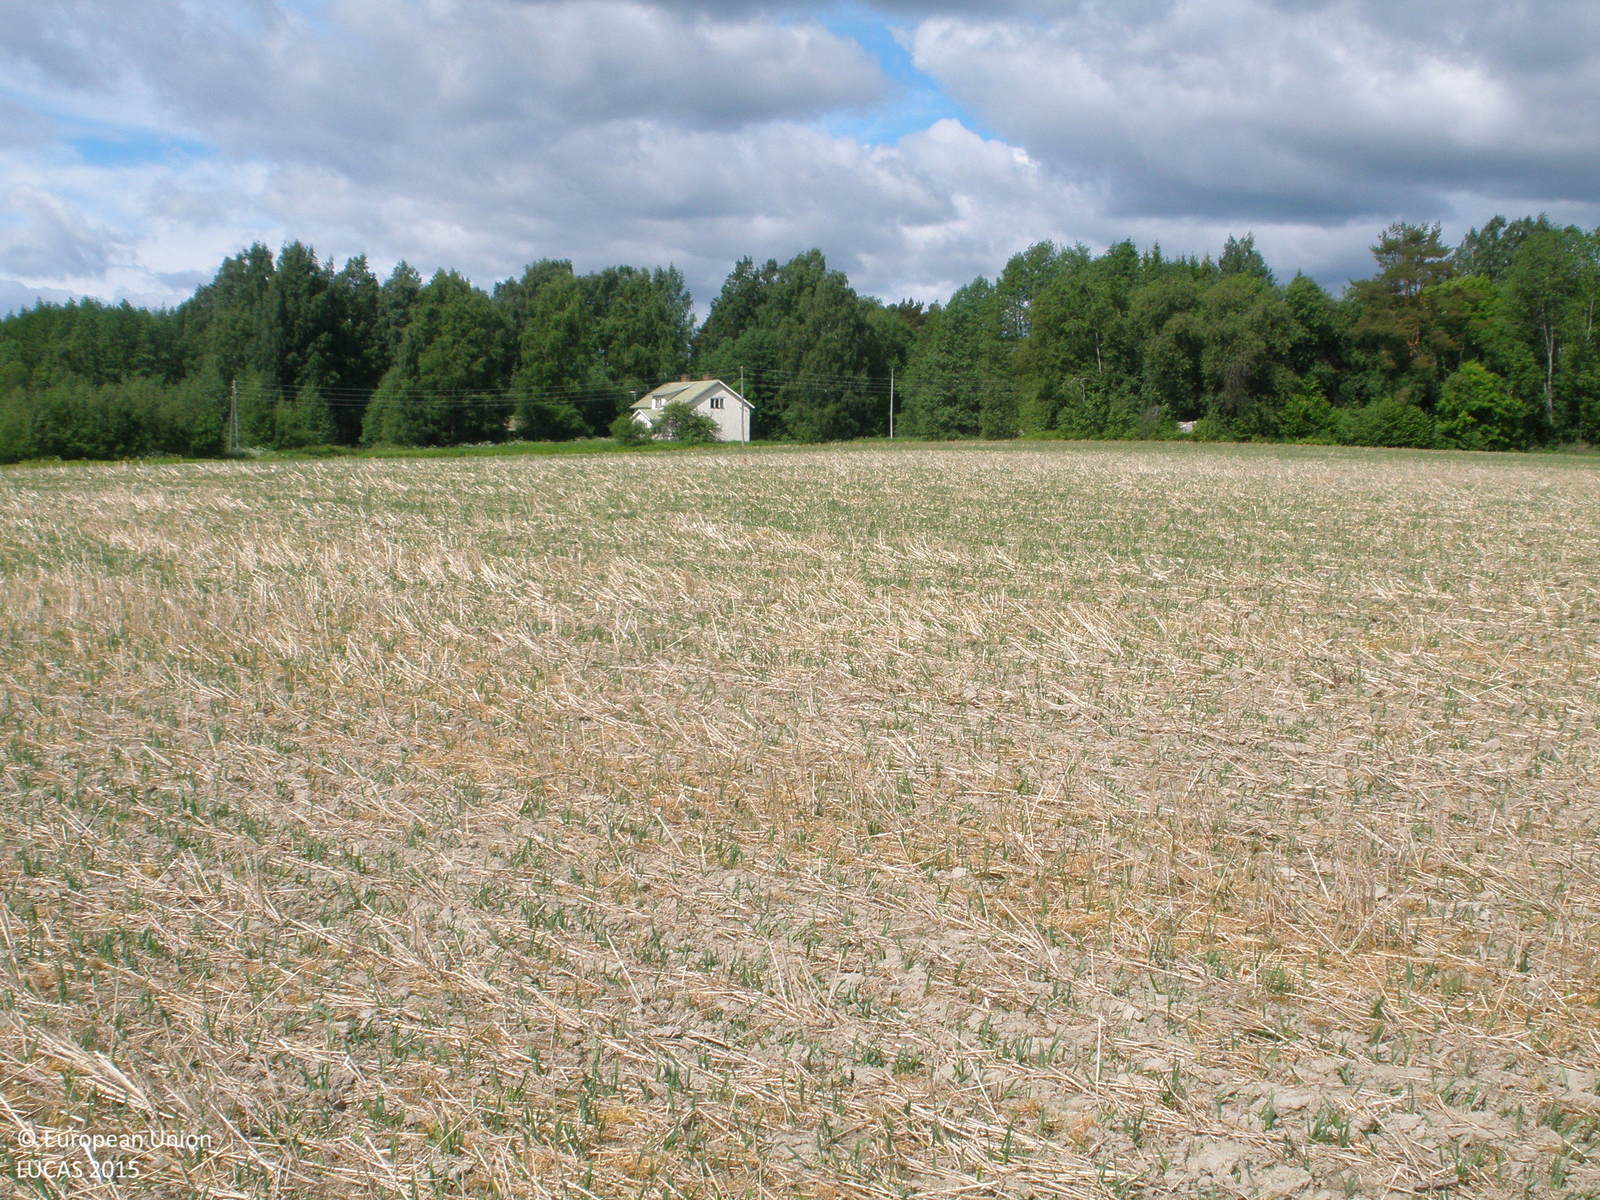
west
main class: Cropland
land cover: Rye
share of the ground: 10 - 25 %
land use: Agriculture (excluding fallow land and kitchen gardens)
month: June
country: FI
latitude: 61.2078
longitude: 24.4882
